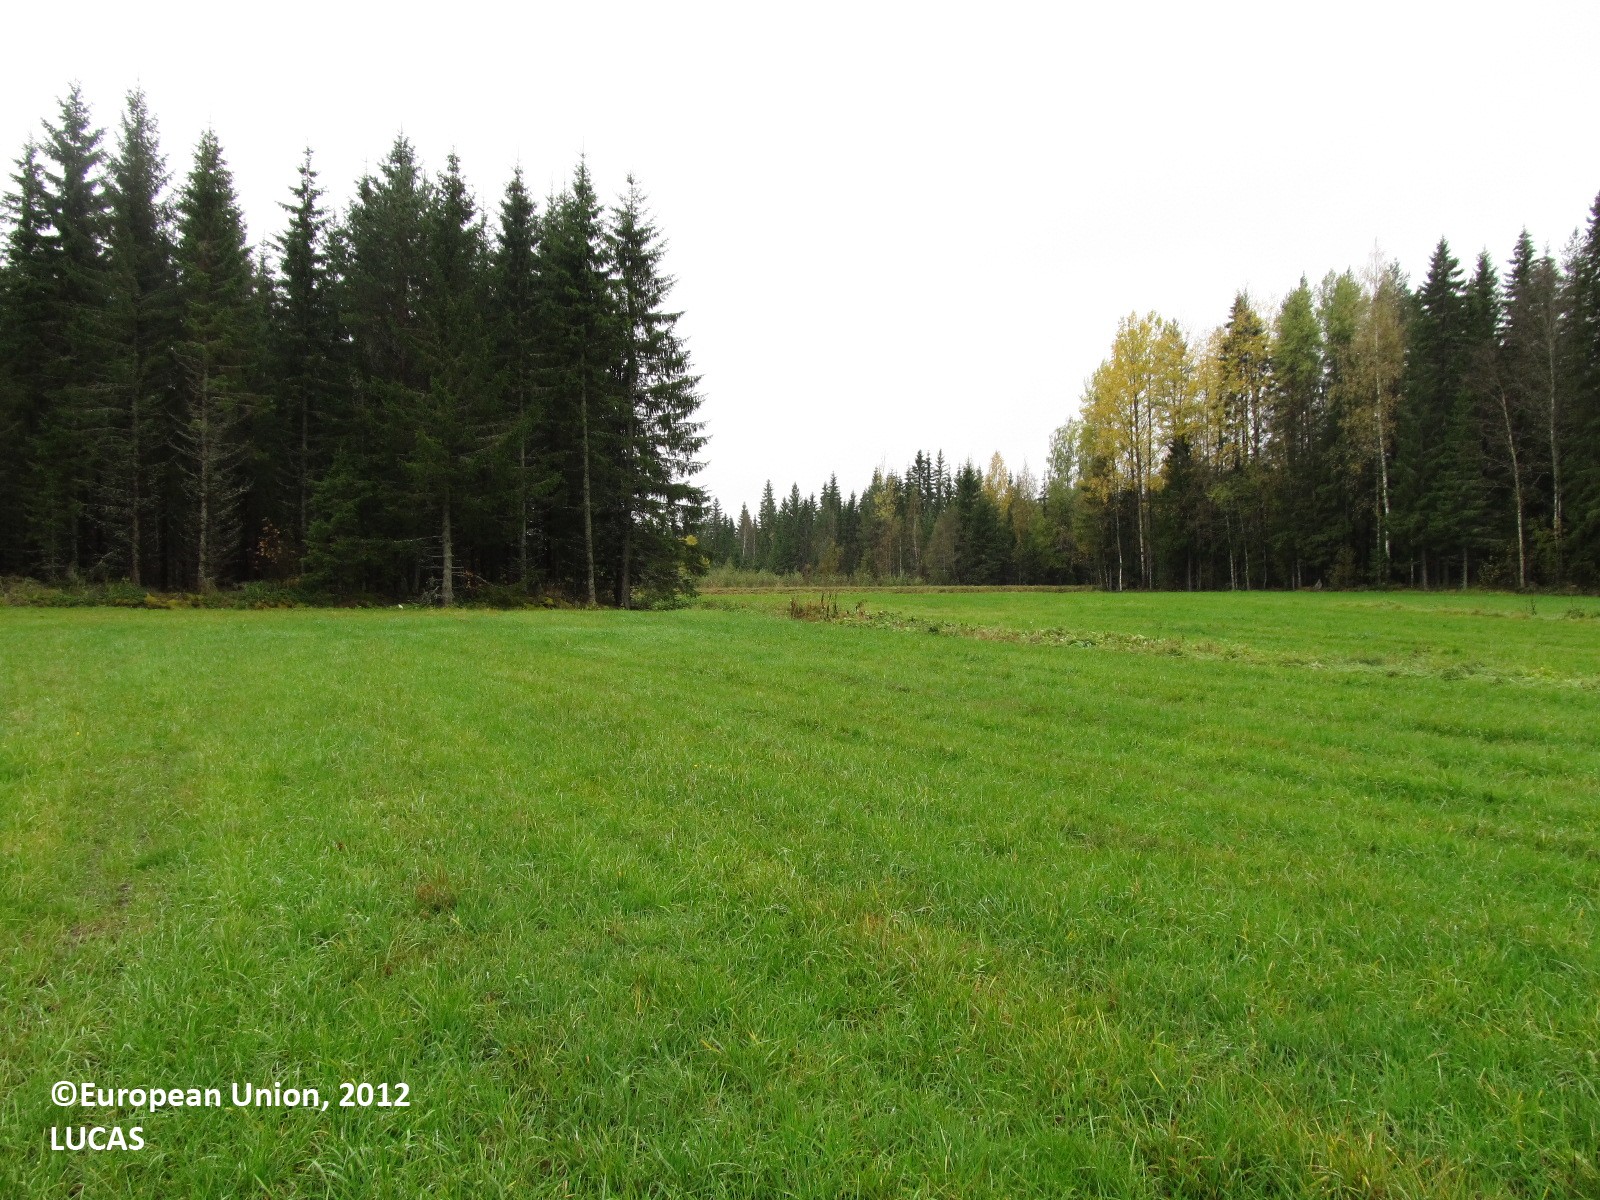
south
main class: Cropland
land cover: Temporary grasslands
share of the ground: > 75 %
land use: Agriculture (excluding fallow land and kitchen gardens)
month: September
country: FI
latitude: 62.5045
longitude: 27.9471
